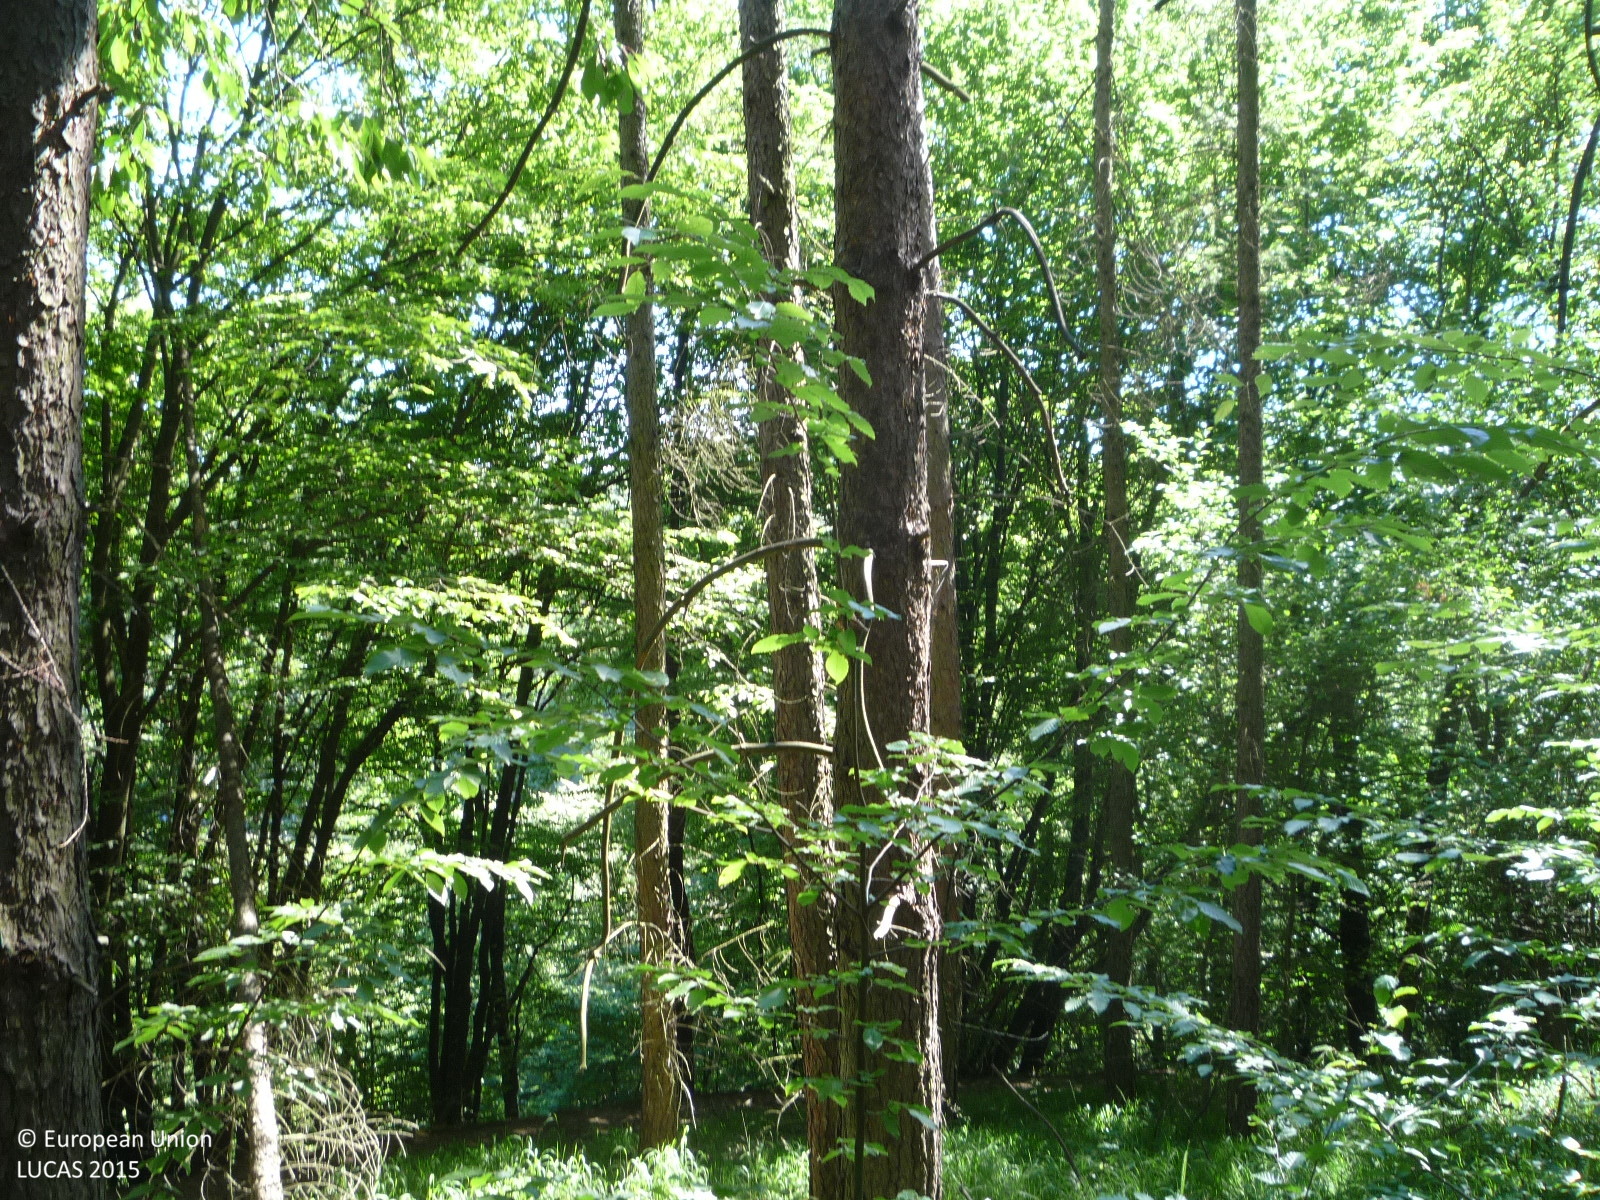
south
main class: Woodland
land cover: Other coniferous woodland
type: hemiboreal forest and nemoral coniferous forest and mixed broadleaved-coniferous forest
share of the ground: > 75 %
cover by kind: coniferous forest trees 90 %, broadleaved forest trees 5 %, herbaceous plants 5 %
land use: Forestry
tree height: > 5 m
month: July
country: CZ
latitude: 50.4727
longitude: 14.5248
